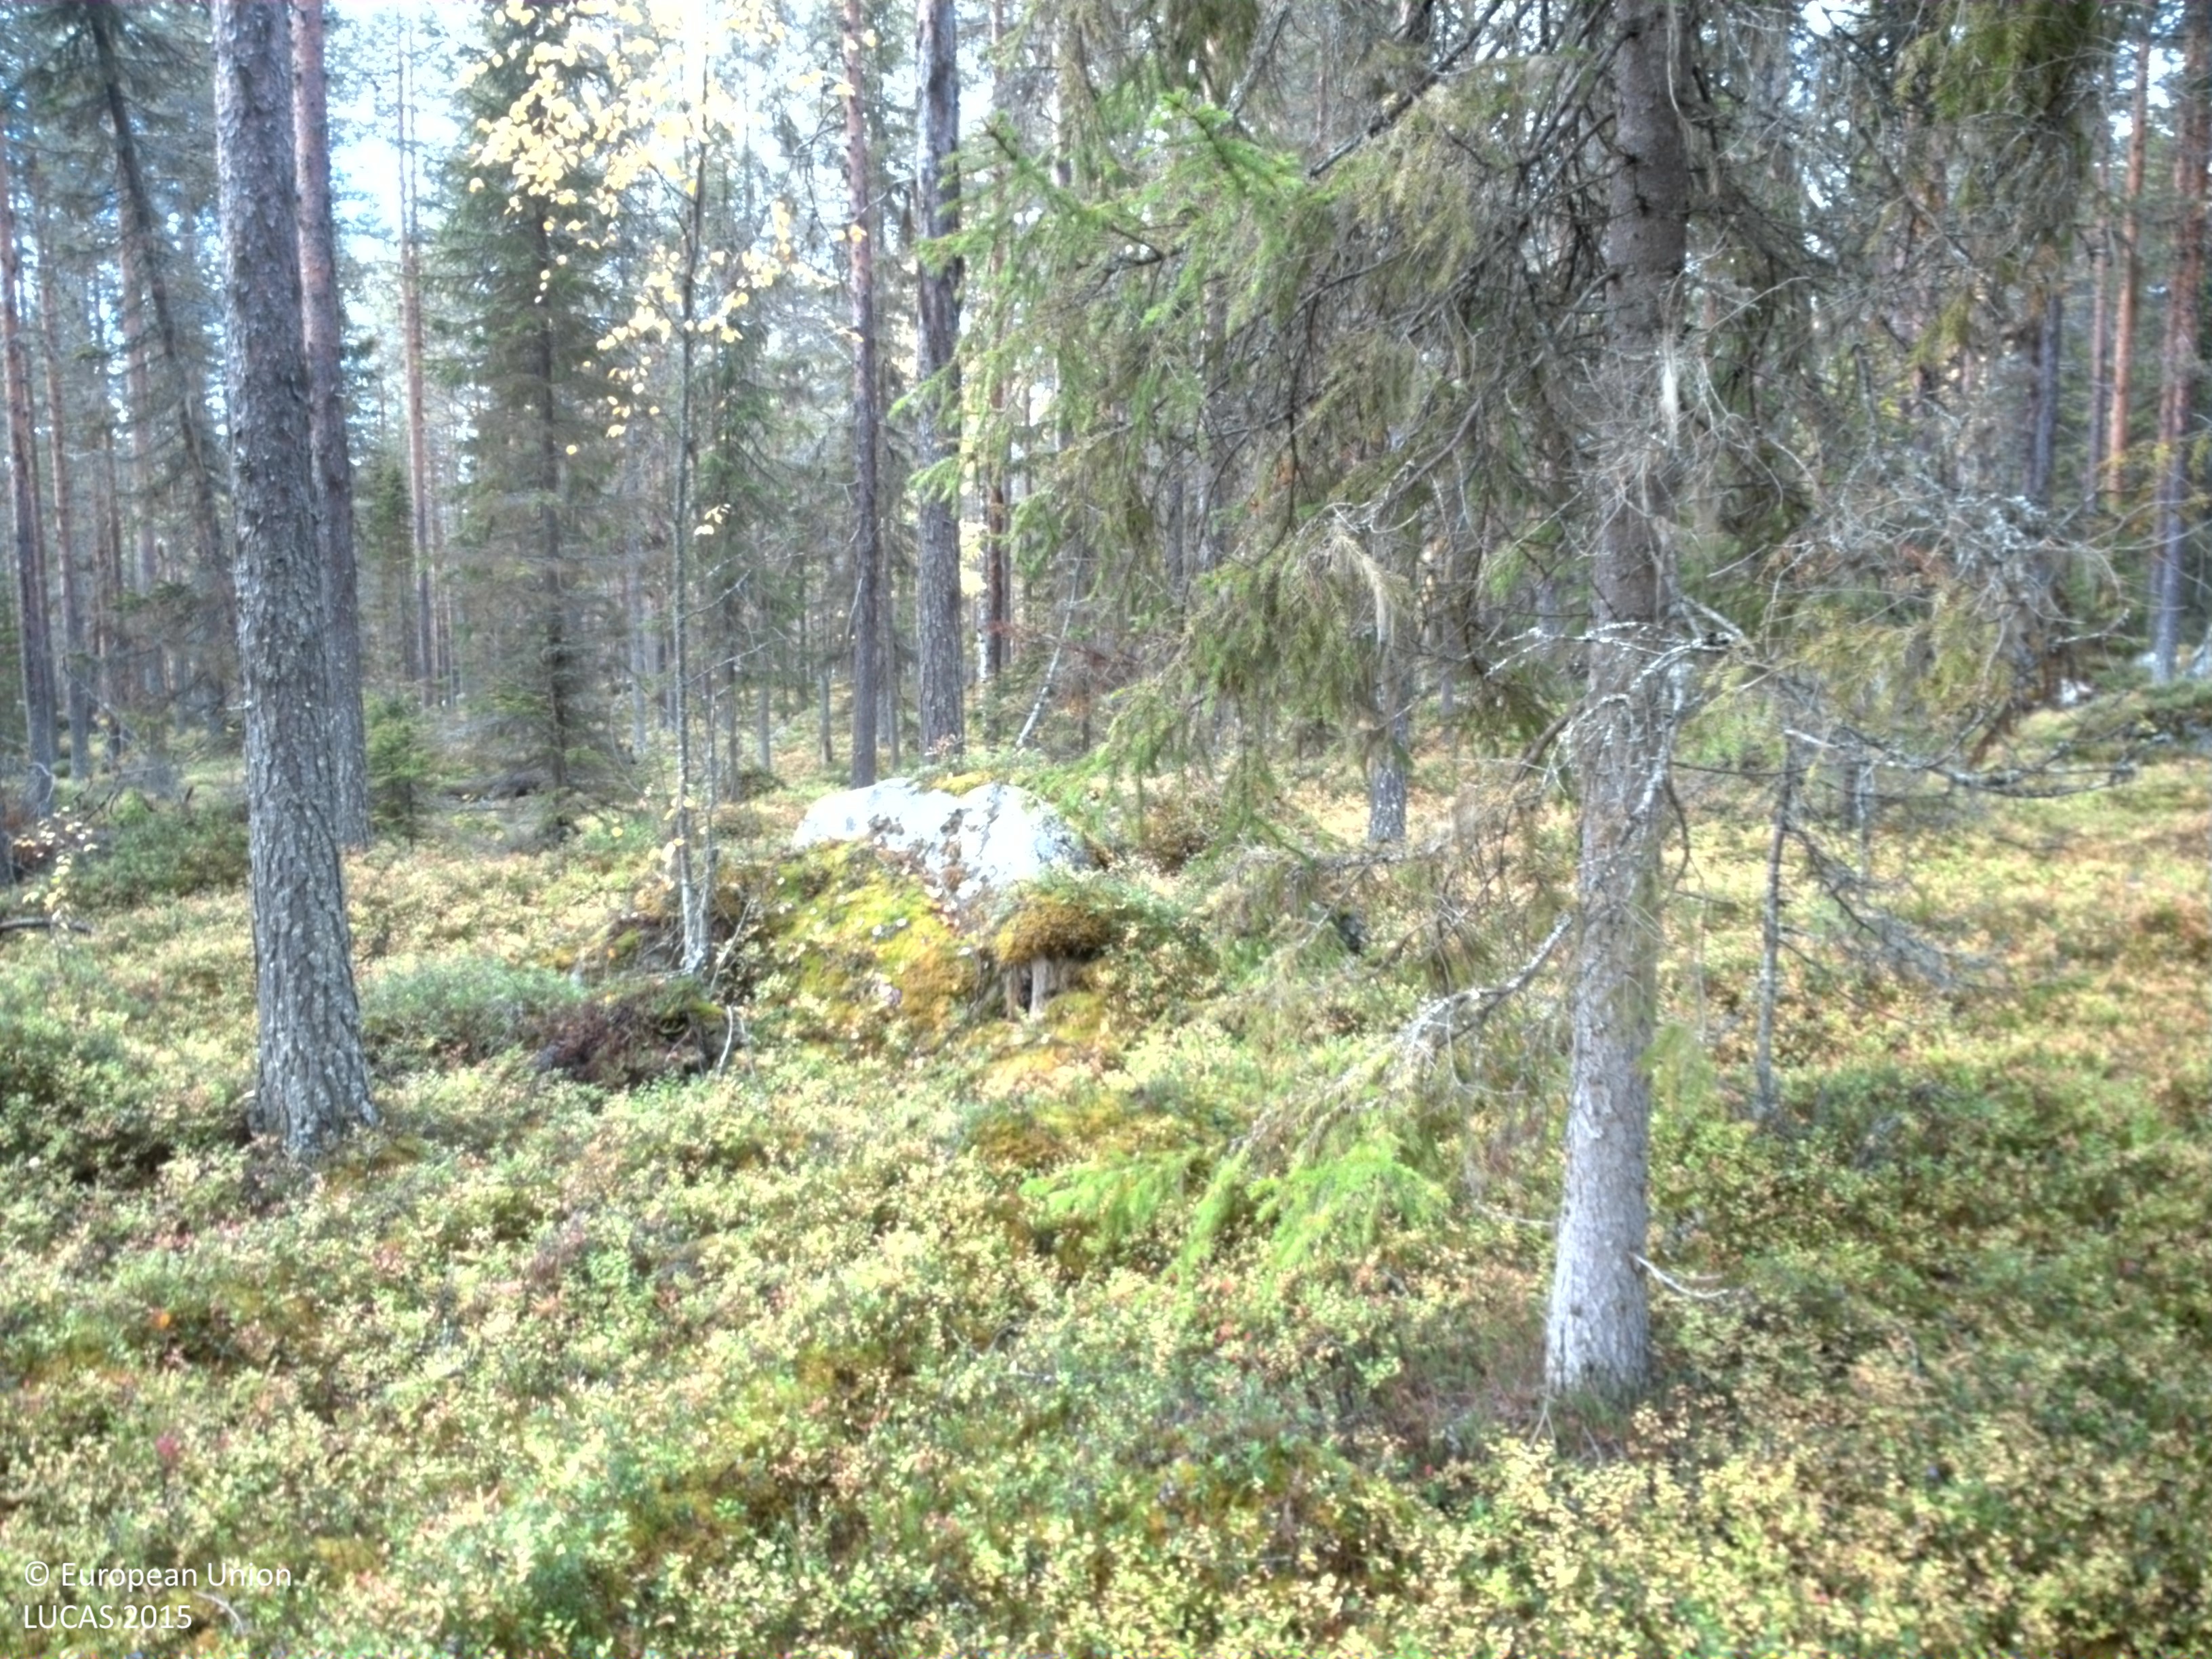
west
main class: Woodland
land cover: Pine dominated coniferous woodland
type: boreal forest
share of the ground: 25 - 50 %
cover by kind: shrubs 45 %, coniferous forest trees 35 %, lichens and mosses 20 %
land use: Forestry
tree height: > 5 m
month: September
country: SE
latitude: 65.1254
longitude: 17.5691
